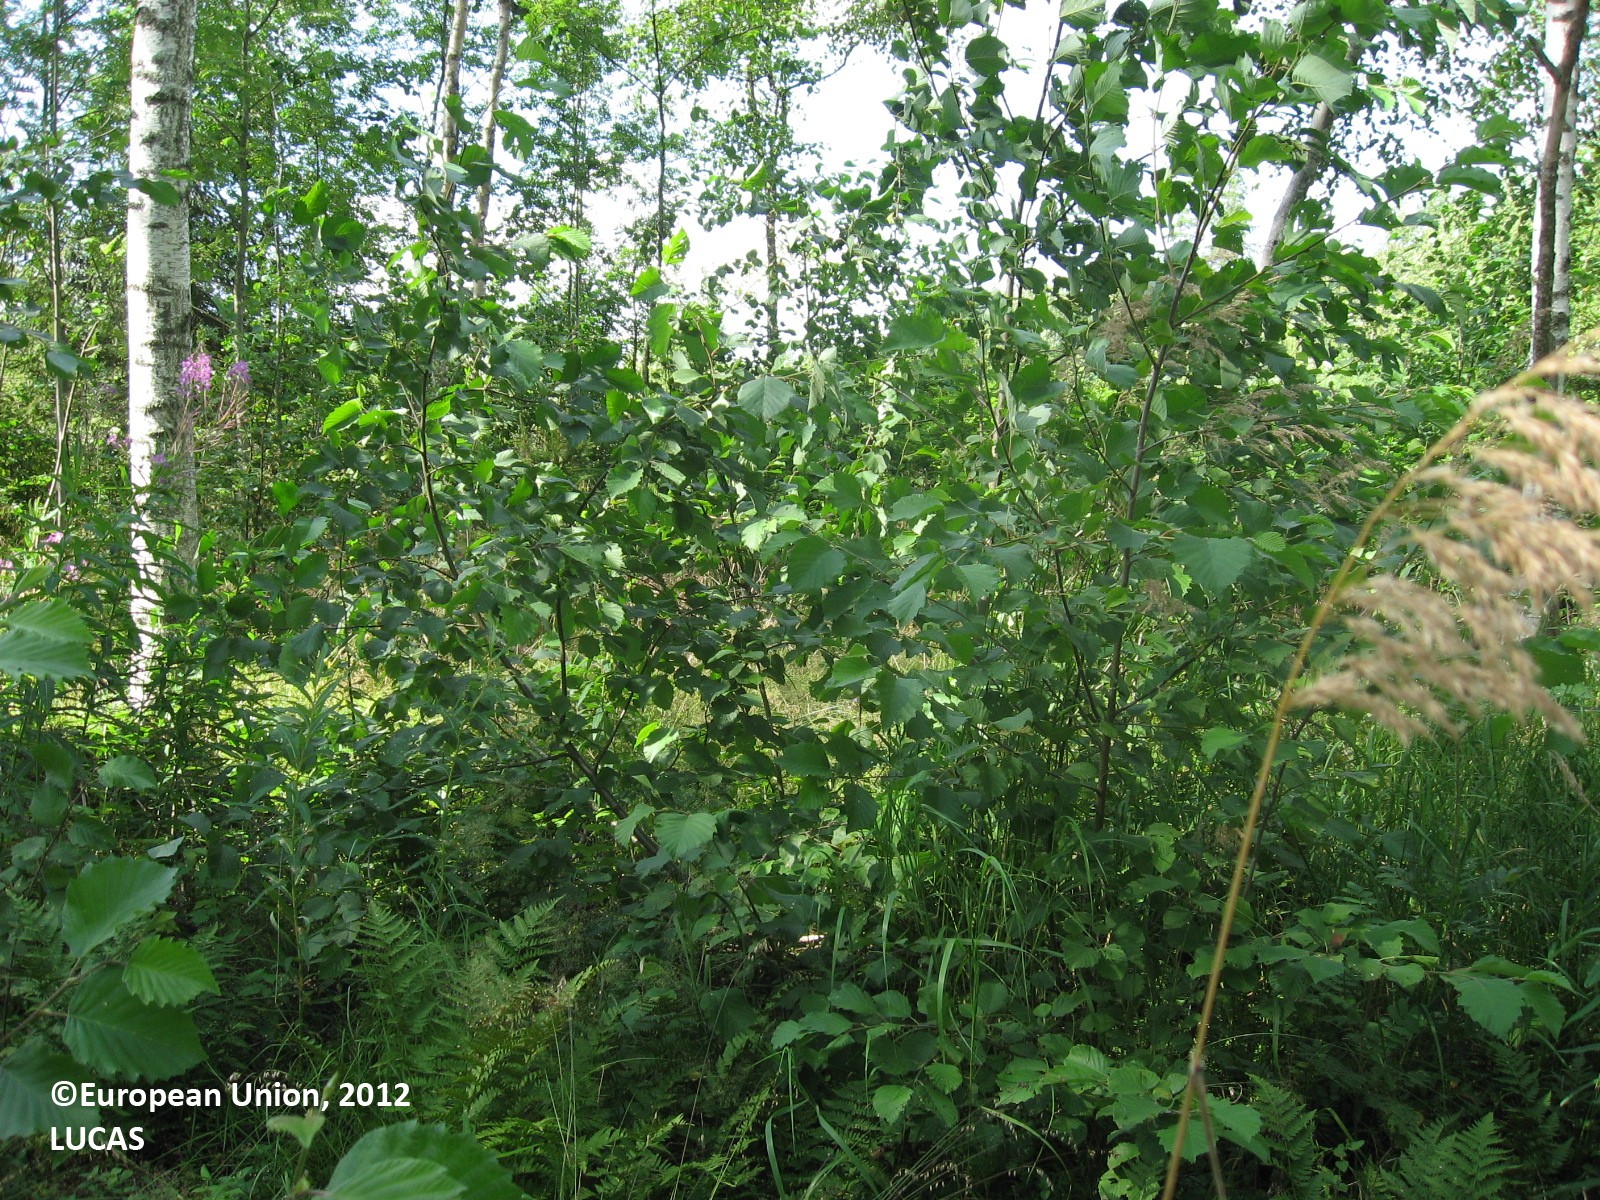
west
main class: Woodland
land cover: Broadleaved woodland
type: boreal forest
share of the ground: > 75 %
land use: Forestry
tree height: > 5 m
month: August
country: FI
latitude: 61.5416
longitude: 26.0302
